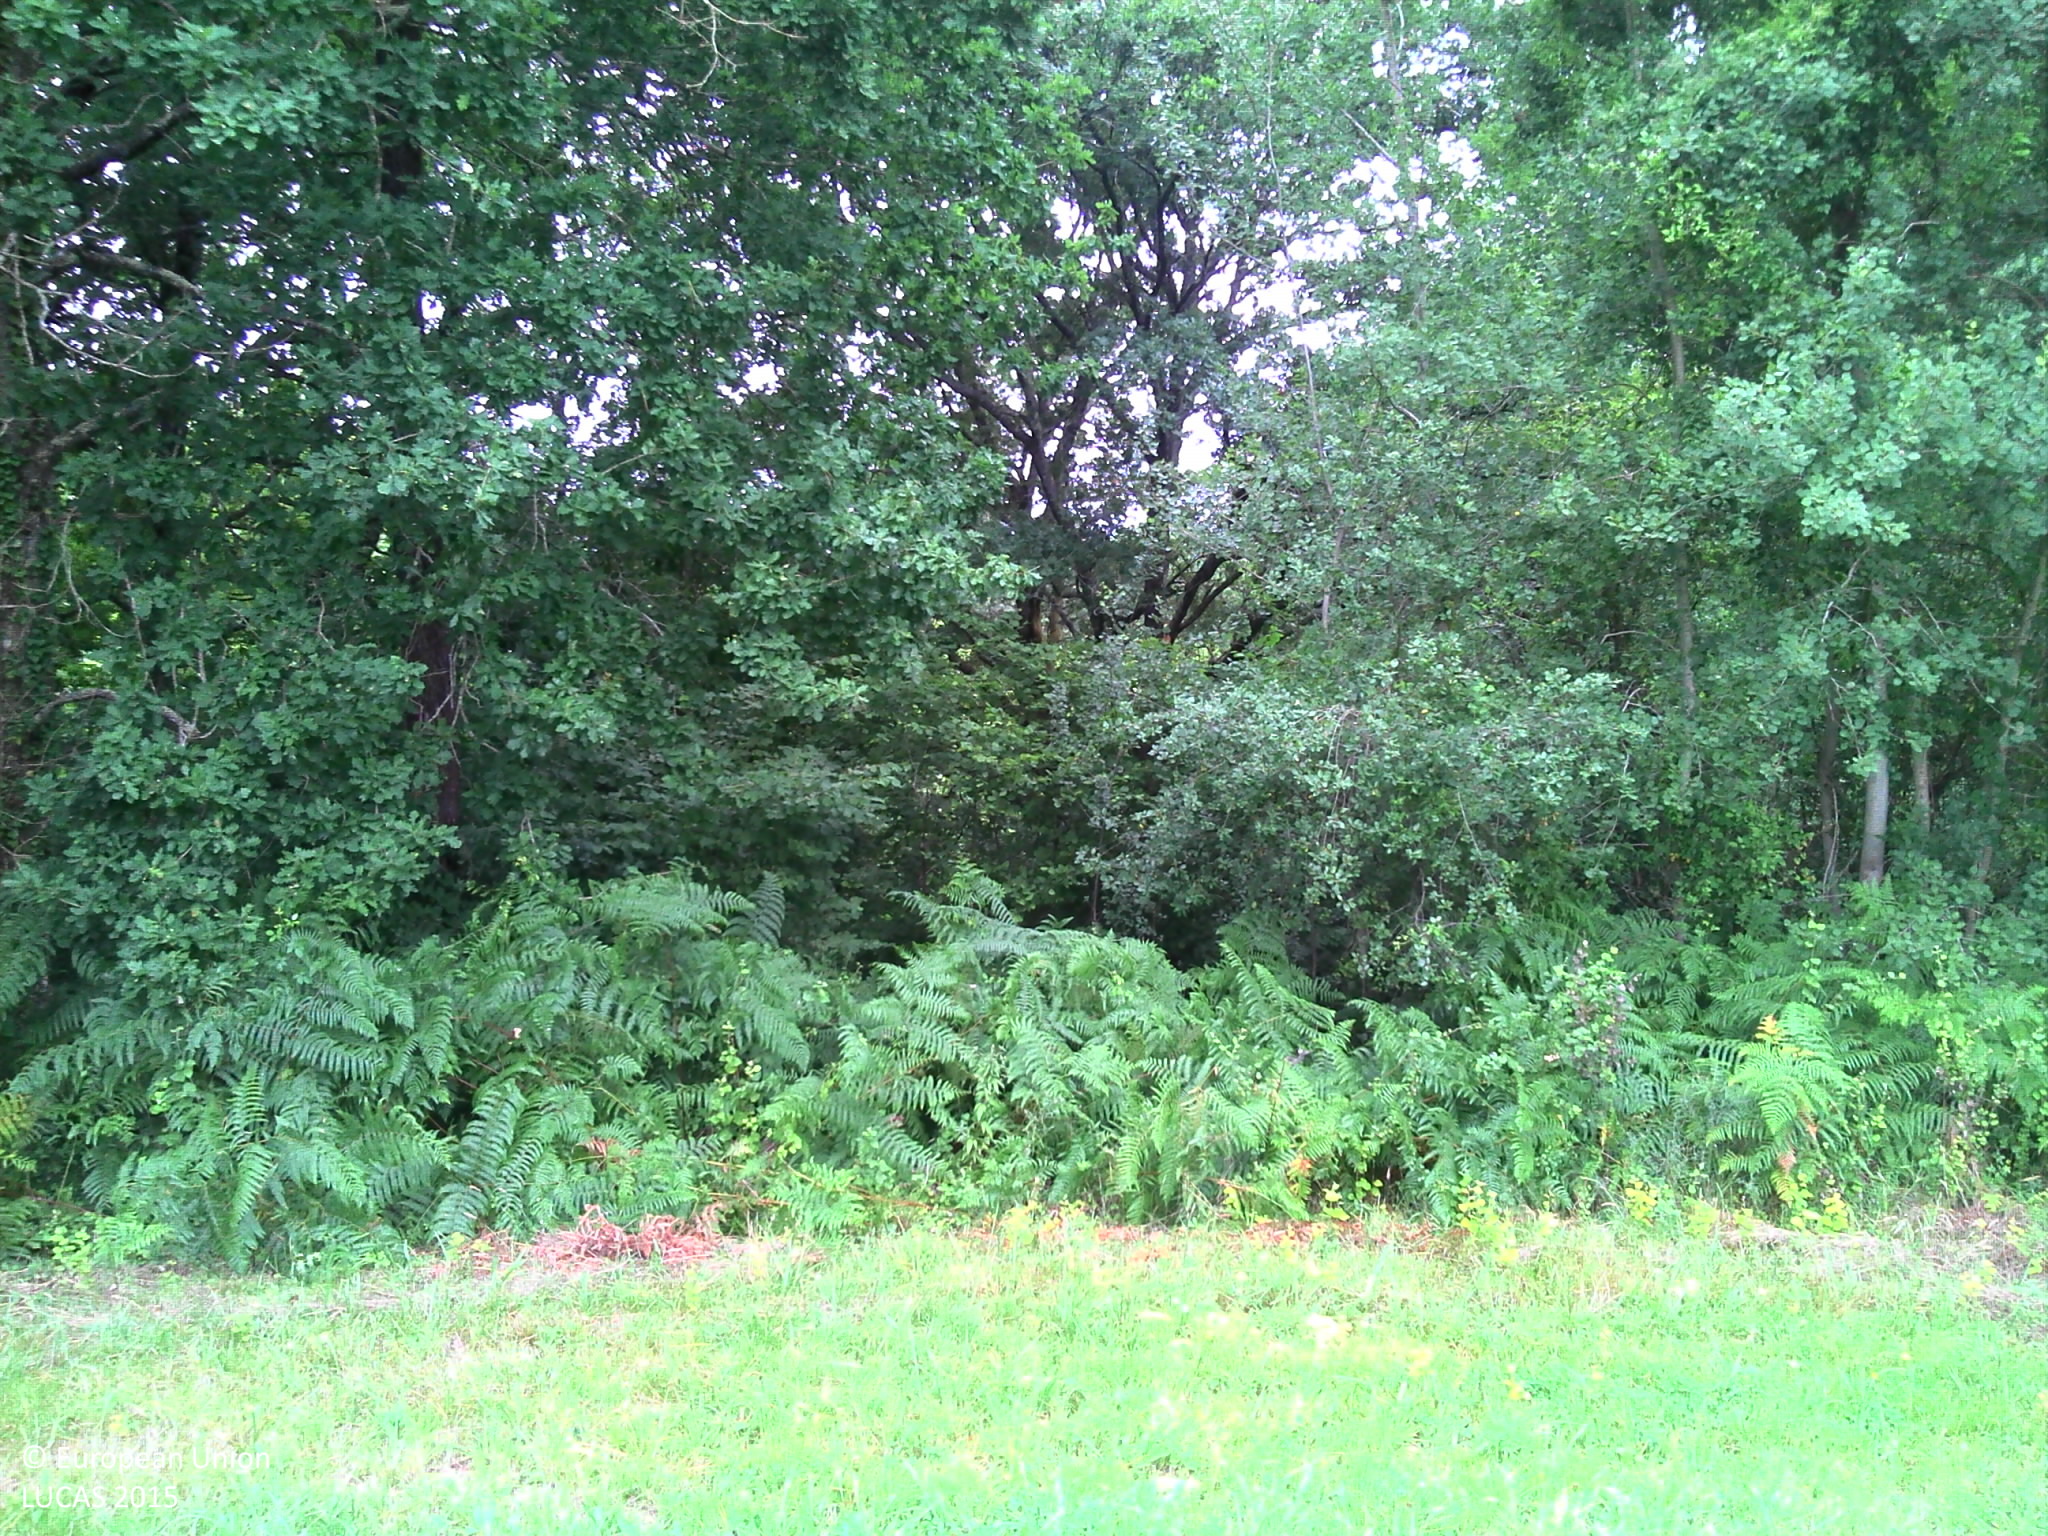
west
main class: Grassland
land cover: Grassland without tree/shrub cover
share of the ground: > 75 %
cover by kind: herbaceous plants 100 %
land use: Agriculture (excluding fallow land and kitchen gardens)
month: July
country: FR
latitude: 43.5759
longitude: -1.2230
